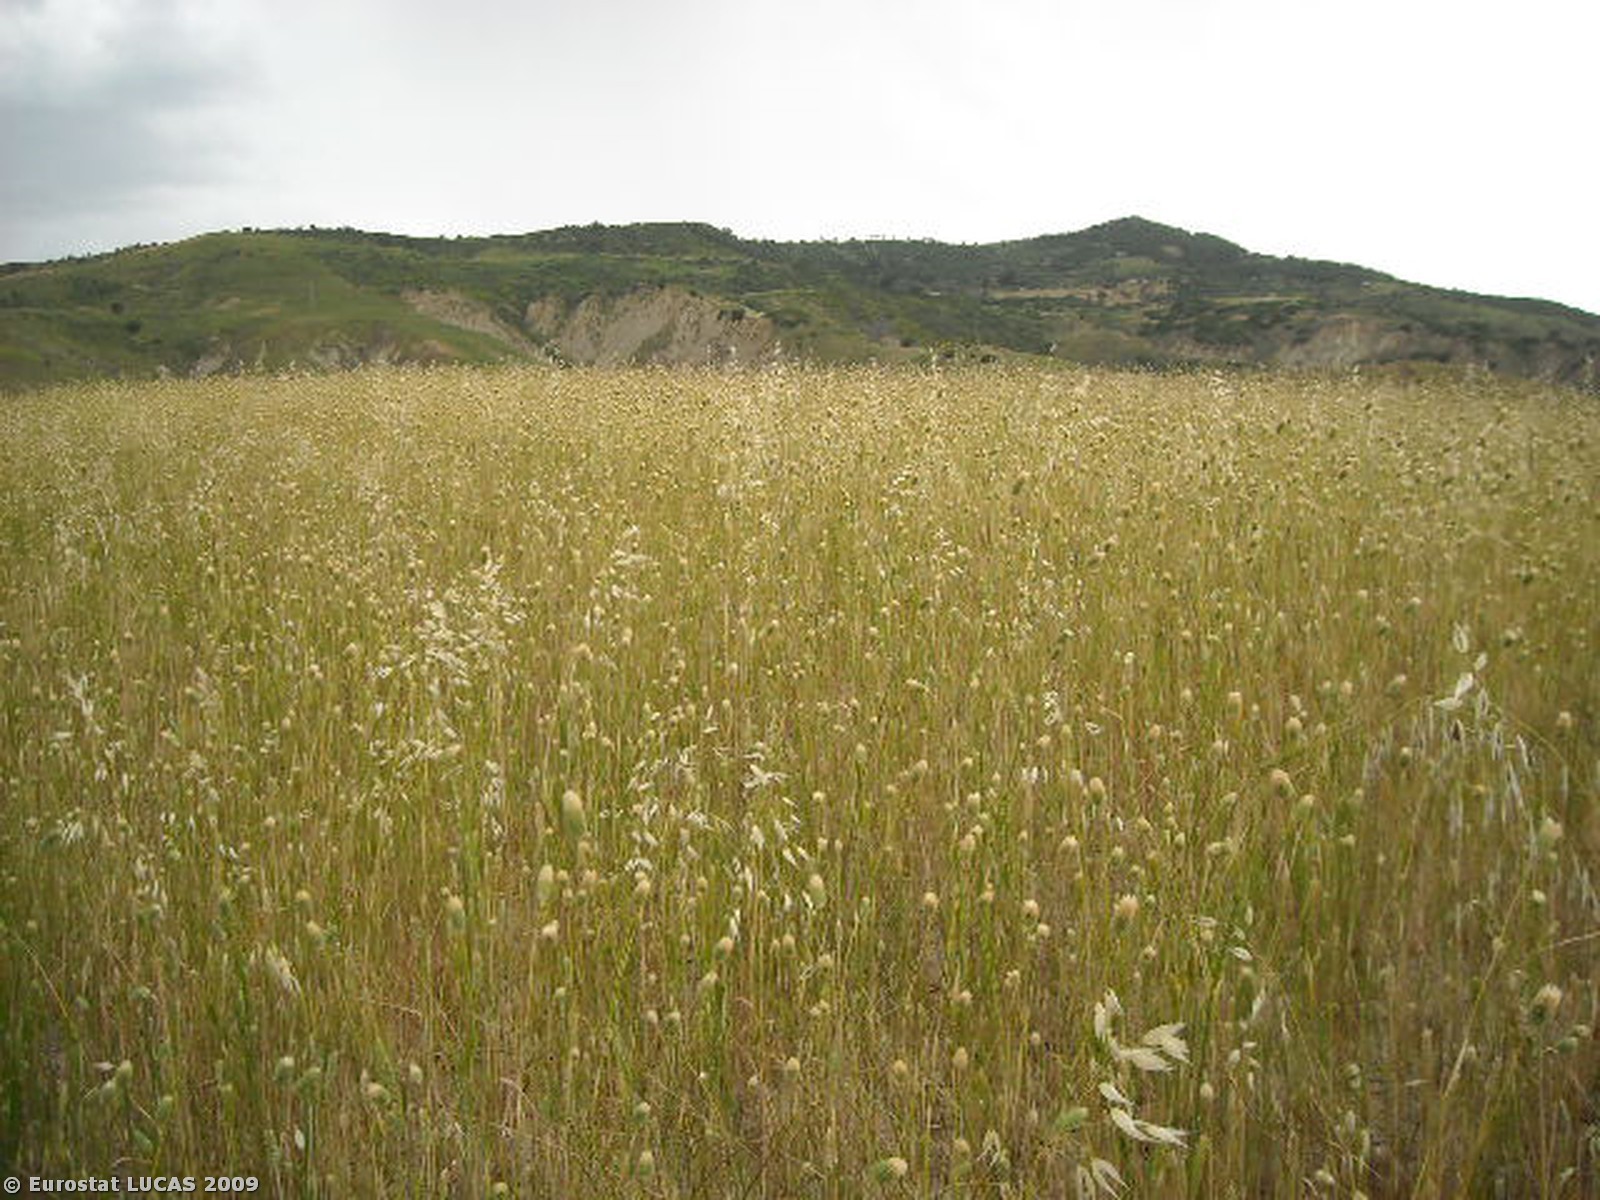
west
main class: Cropland
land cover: Durum wheat
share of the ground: > 75 %
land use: Agriculture (excluding fallow land and kitchen gardens)
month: May
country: IT
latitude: 40.5366
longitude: 16.5758
